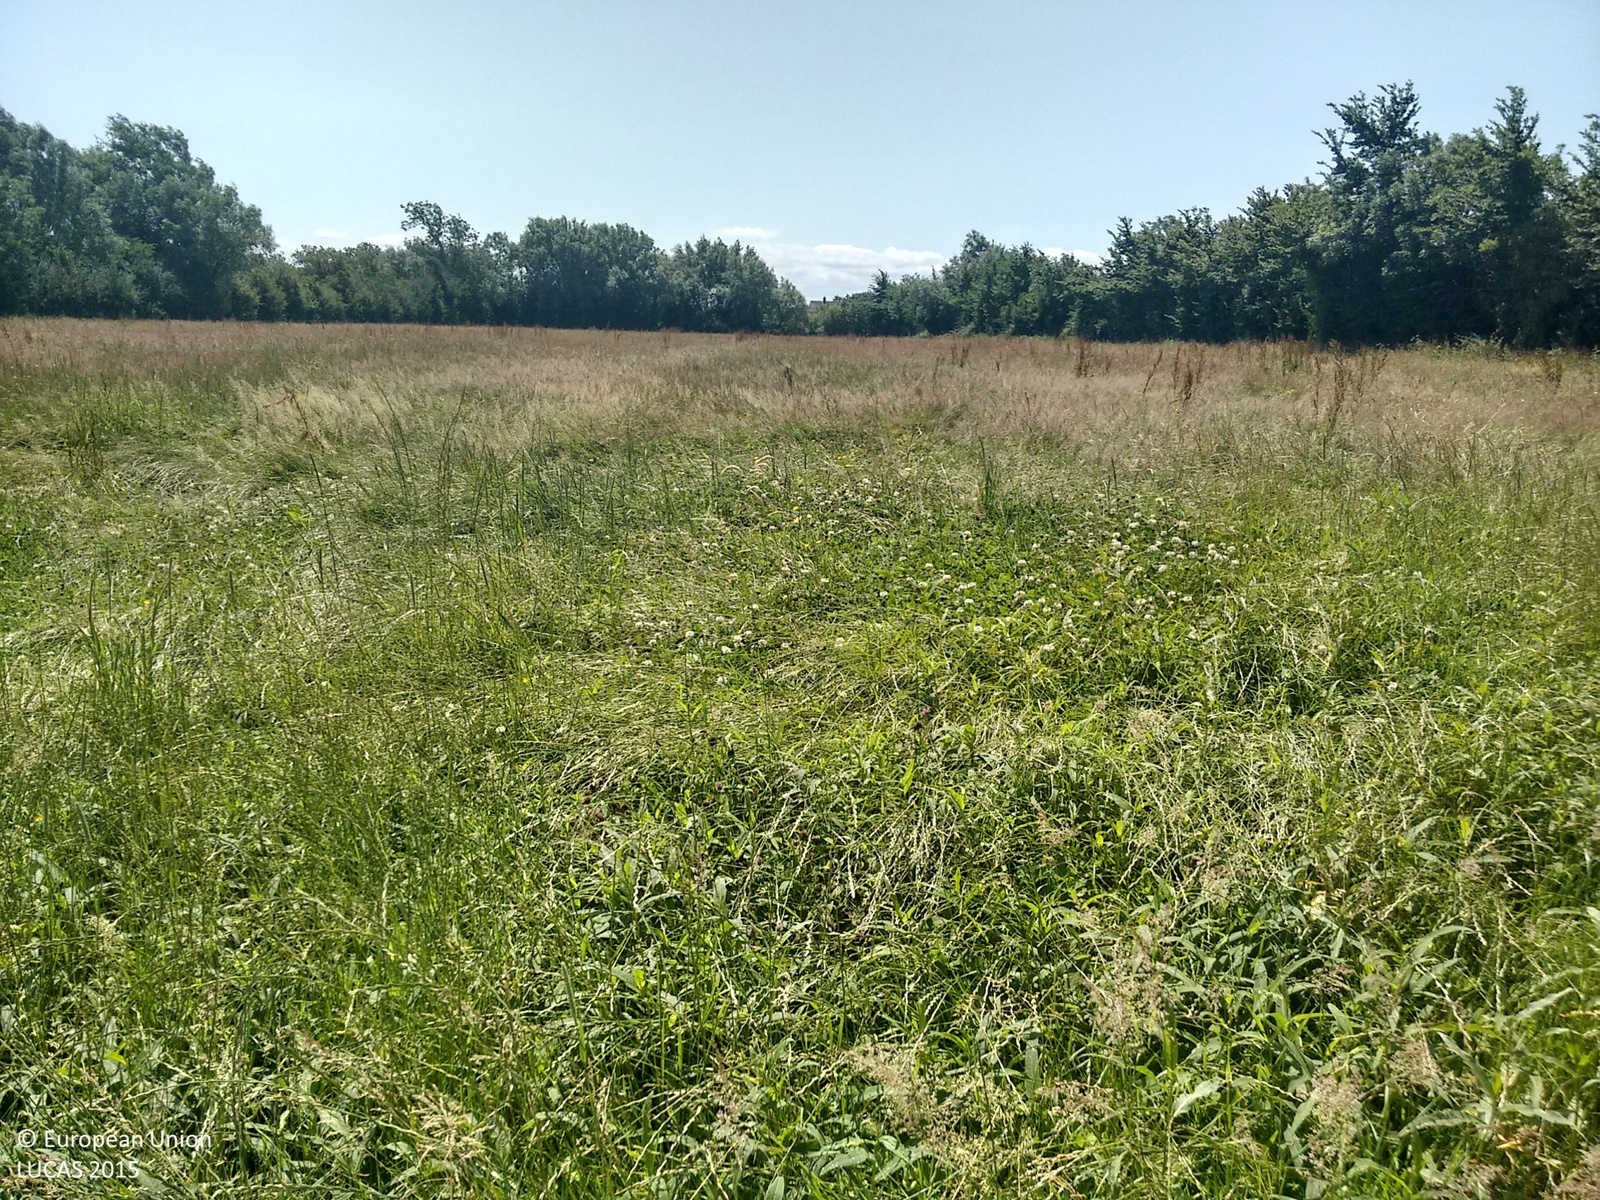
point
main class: Grassland
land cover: Grassland without tree/shrub cover
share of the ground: > 75 %
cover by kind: herbaceous plants 100 %
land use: Agriculture (excluding fallow land and kitchen gardens)
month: July
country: GB
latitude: 51.2658
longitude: -2.9295
